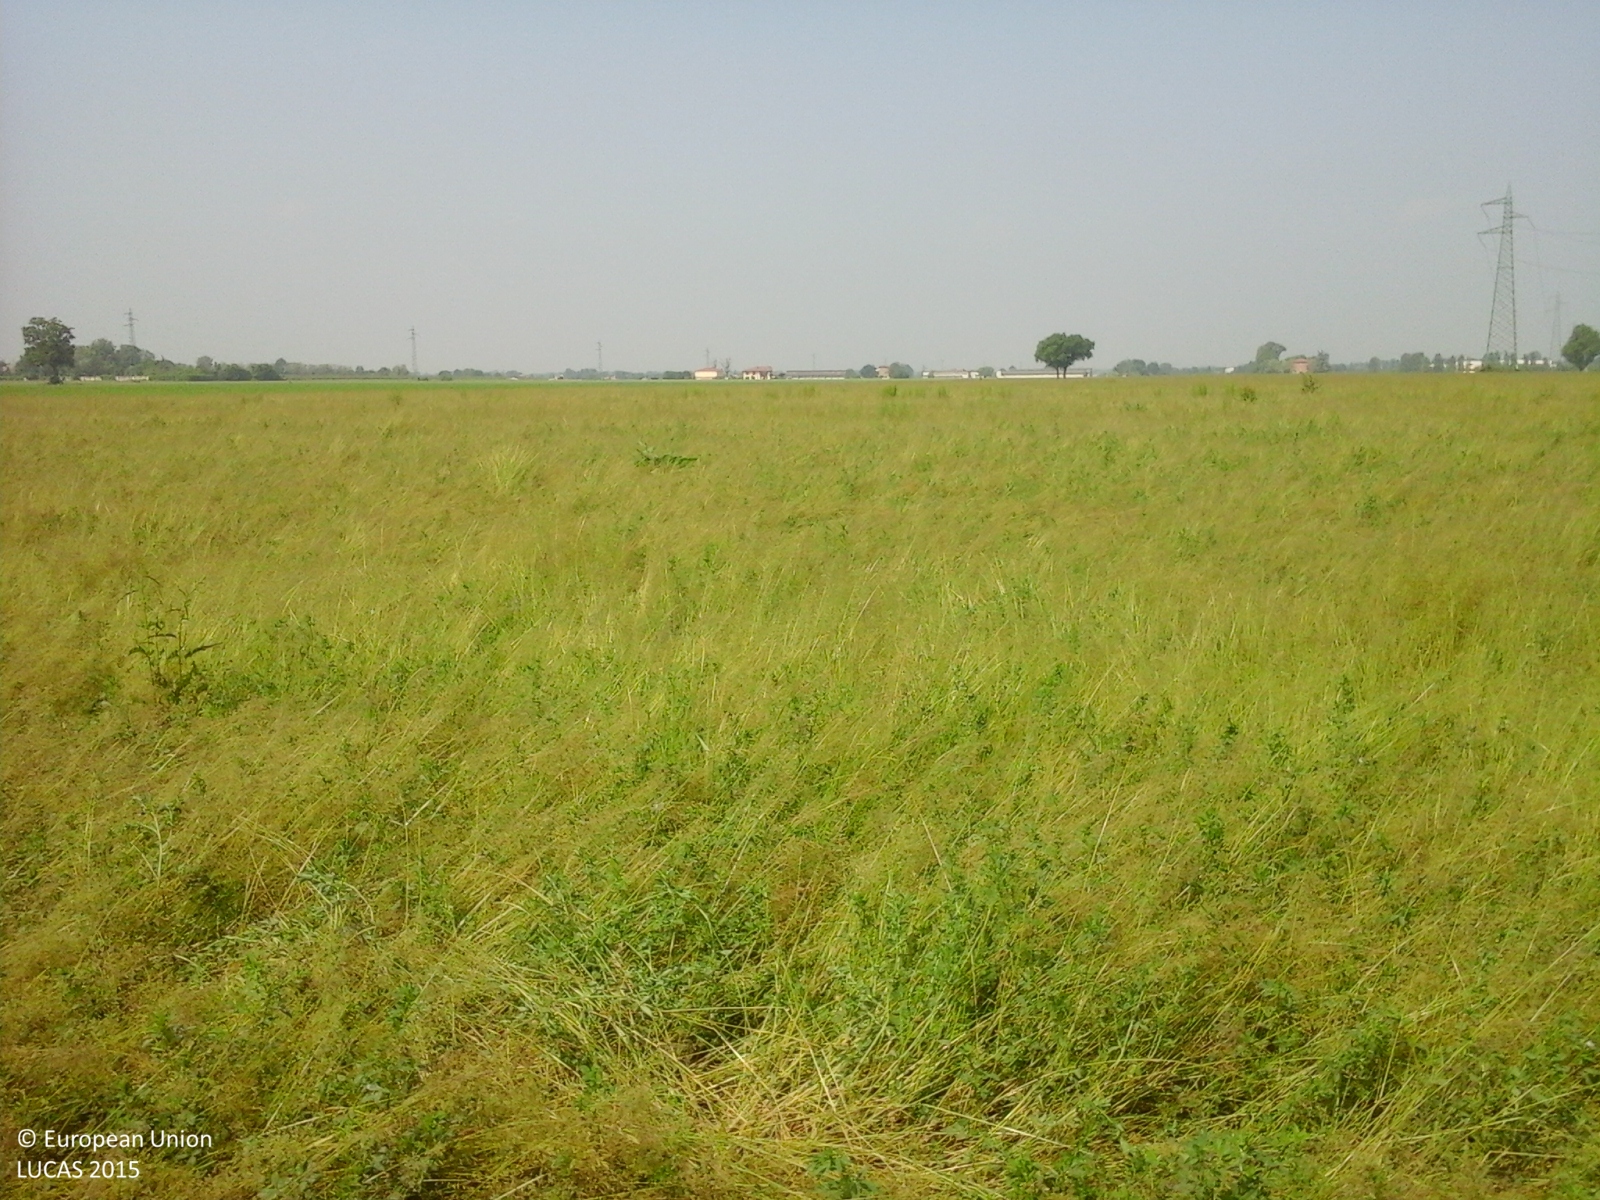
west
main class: Cropland
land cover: Lucerne
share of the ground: > 75 %
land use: Agriculture (excluding fallow land and kitchen gardens)
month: May
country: IT
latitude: 44.5798
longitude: 11.0431
